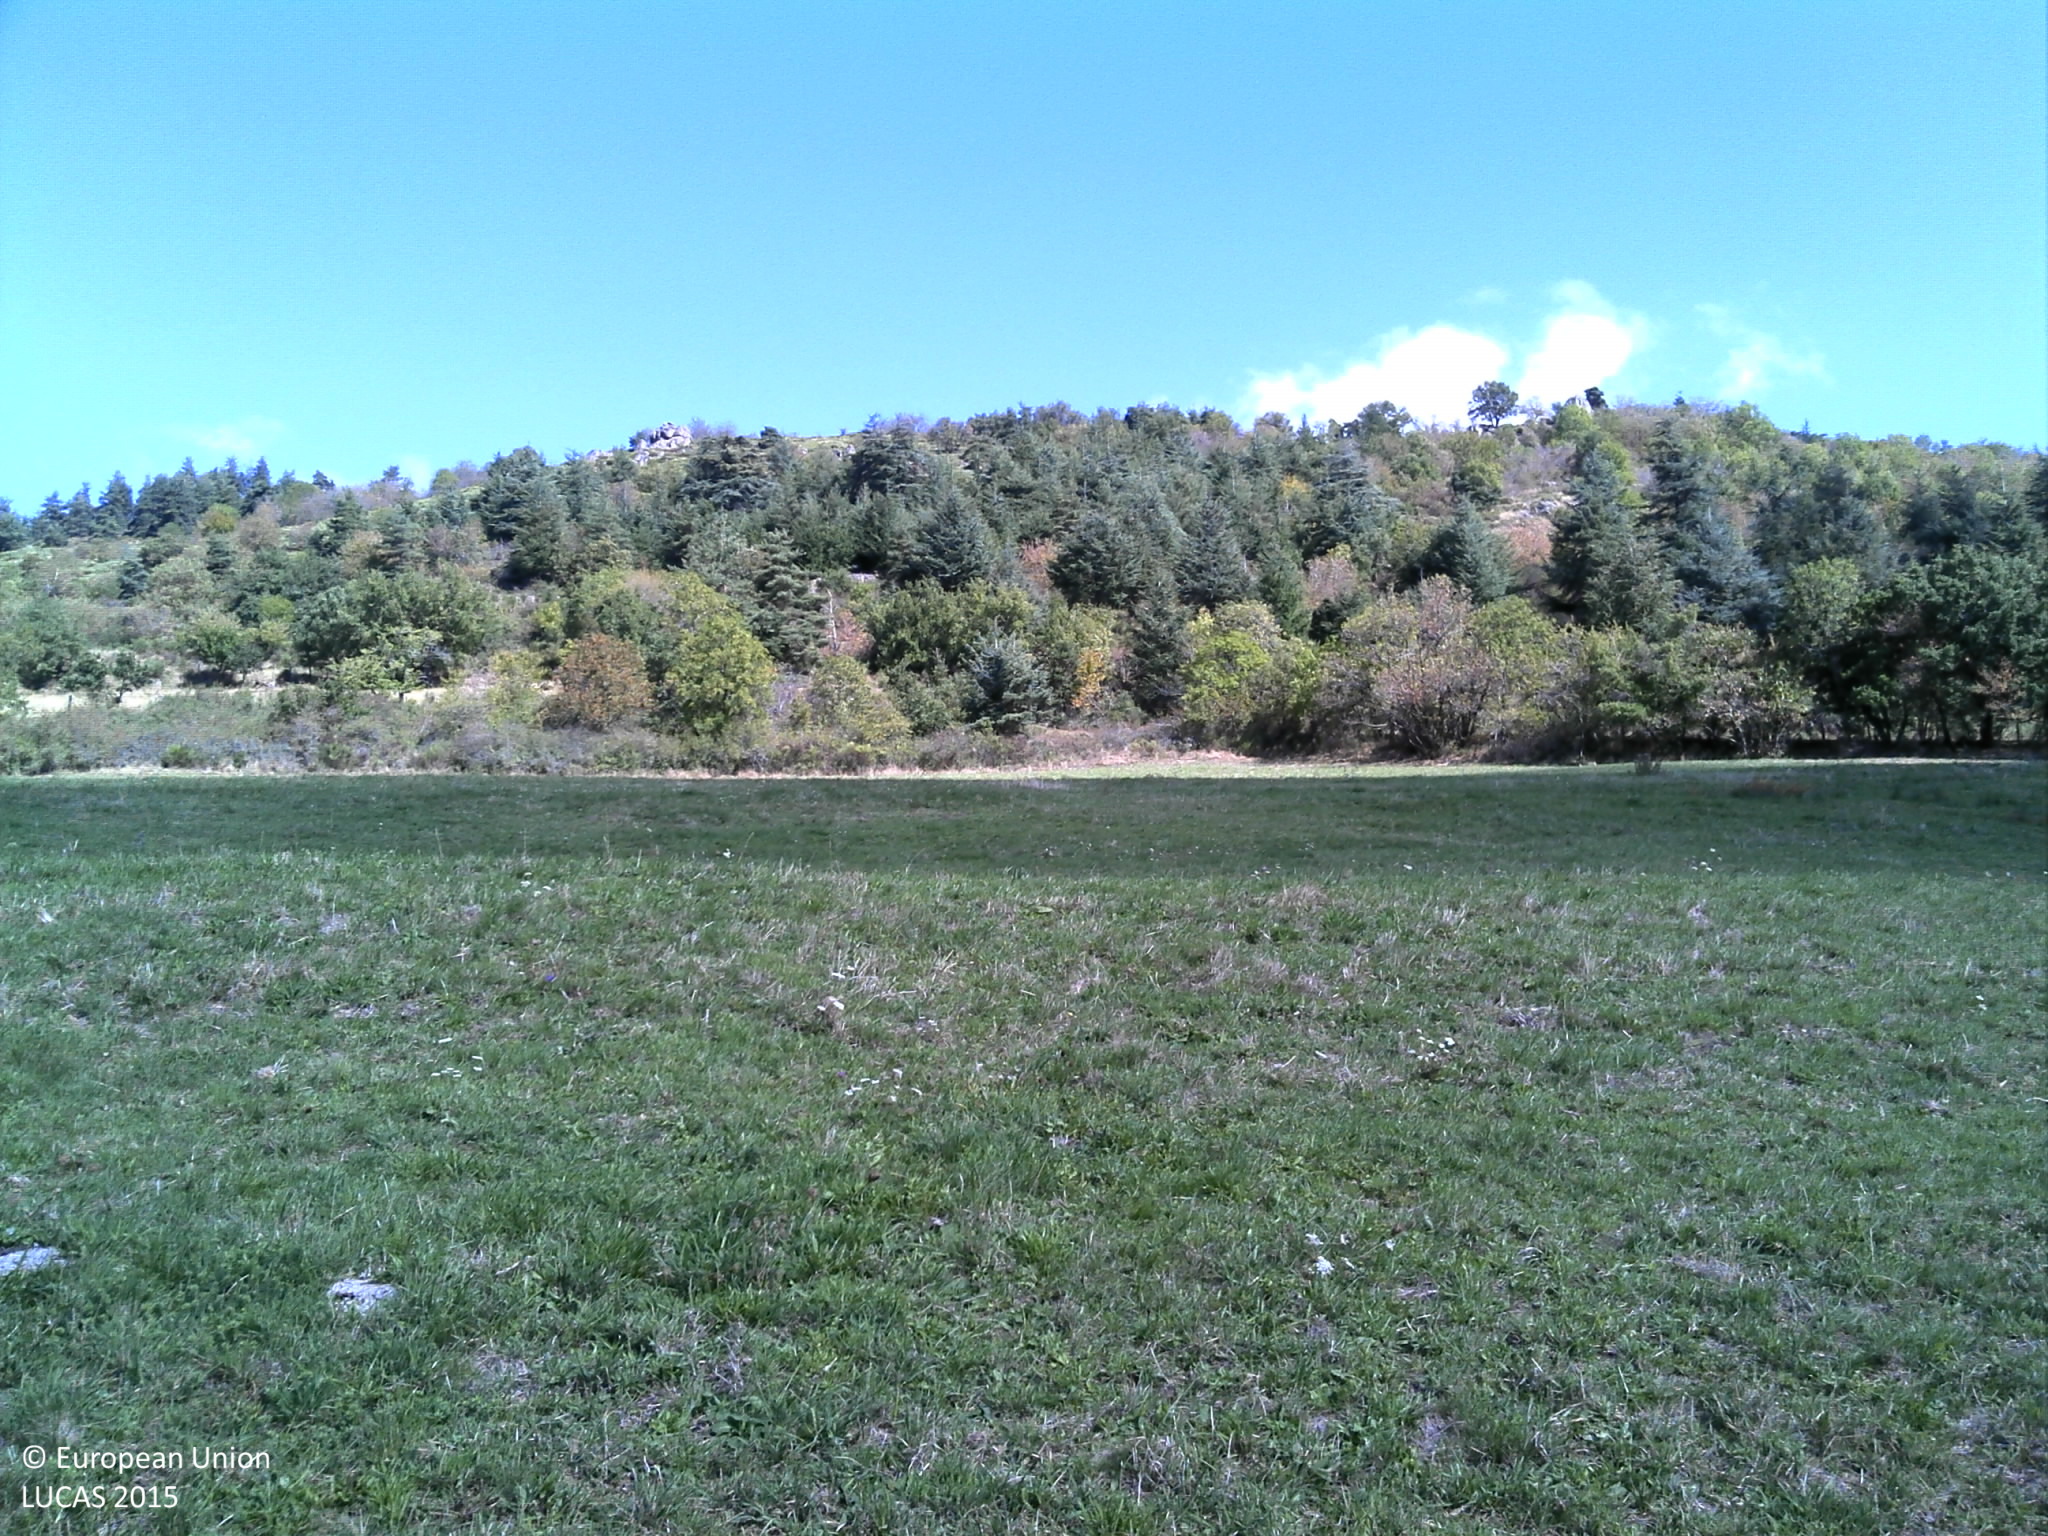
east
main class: Grassland
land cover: Grassland without tree/shrub cover
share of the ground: > 75 %
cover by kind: herbaceous plants 100 %
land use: Agriculture (excluding fallow land and kitchen gardens)
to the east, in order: Grassland without tree/shrub cover; Broadleaved woodland; Fences; Abandoned hedges; Tracks; Broadleaved woodland
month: September
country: FR
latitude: 45.2380
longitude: 4.5652
